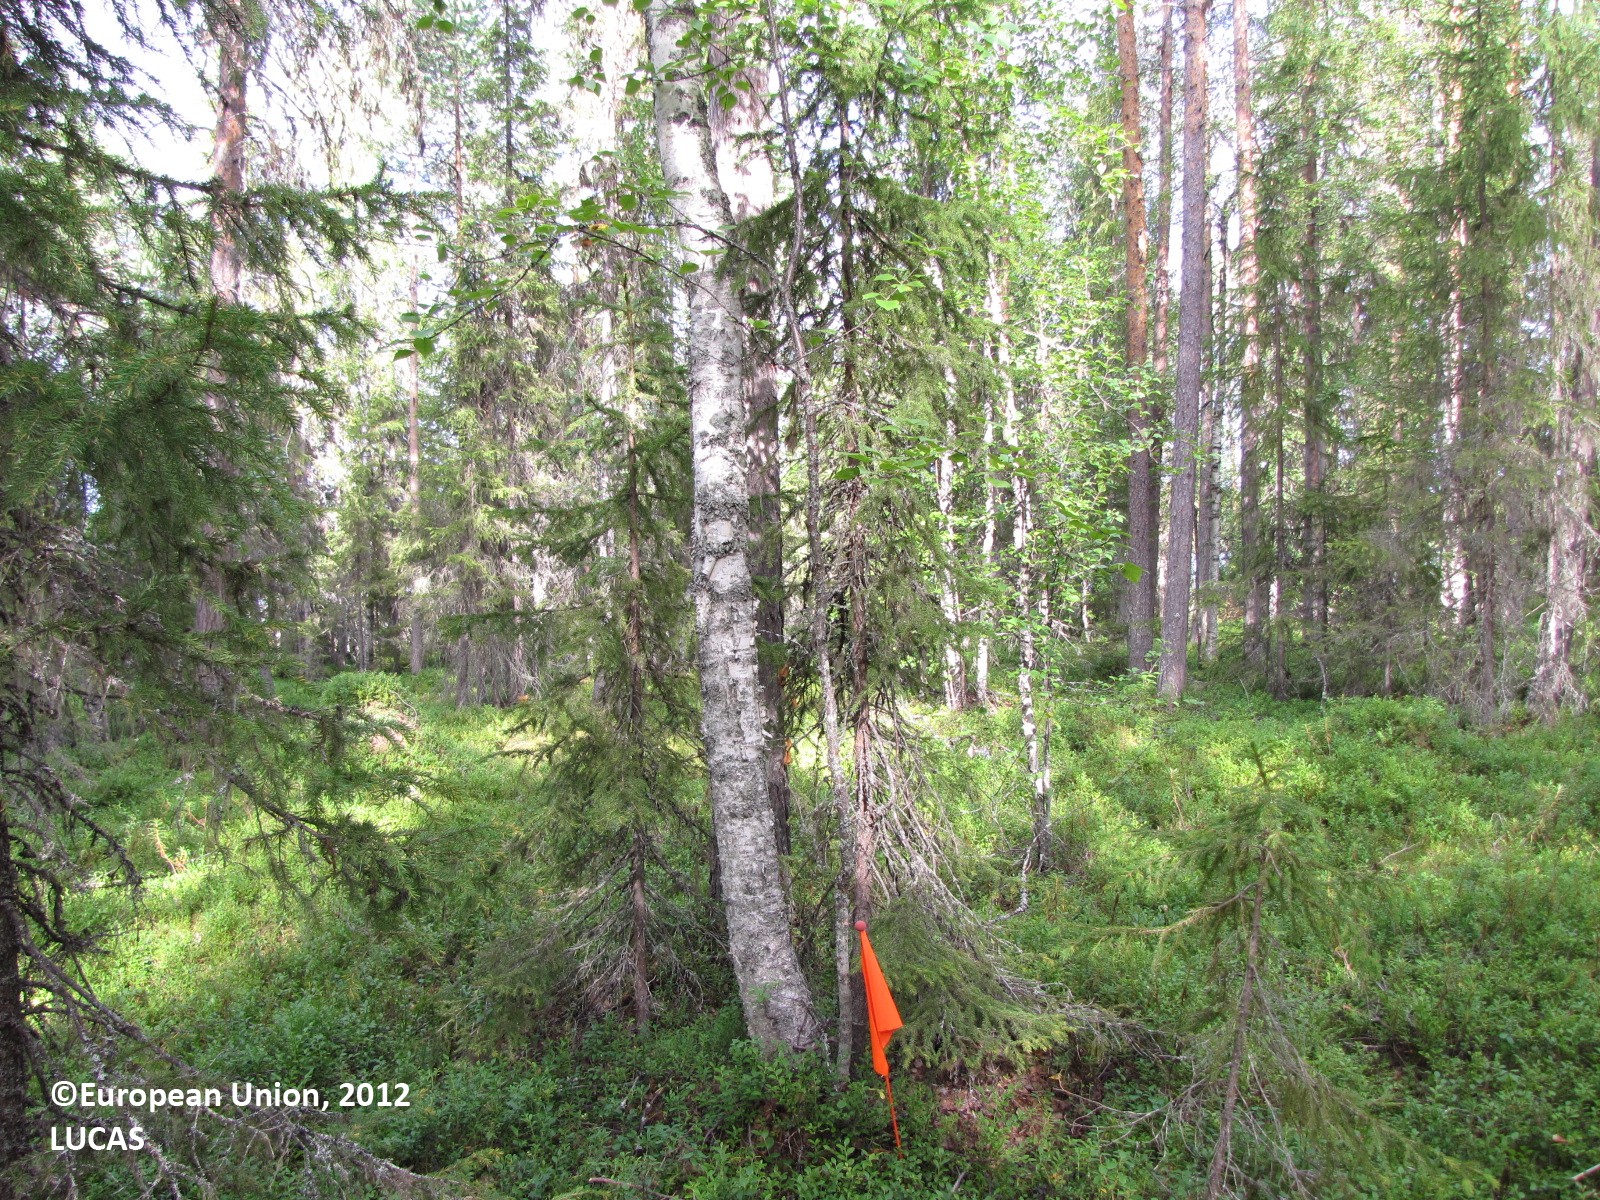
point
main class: Woodland
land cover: Other coniferous woodland
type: boreal forest
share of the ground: 25 - 50 %
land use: Forestry
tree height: > 5 m
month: August
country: FI
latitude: 66.8626
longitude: 25.1724
